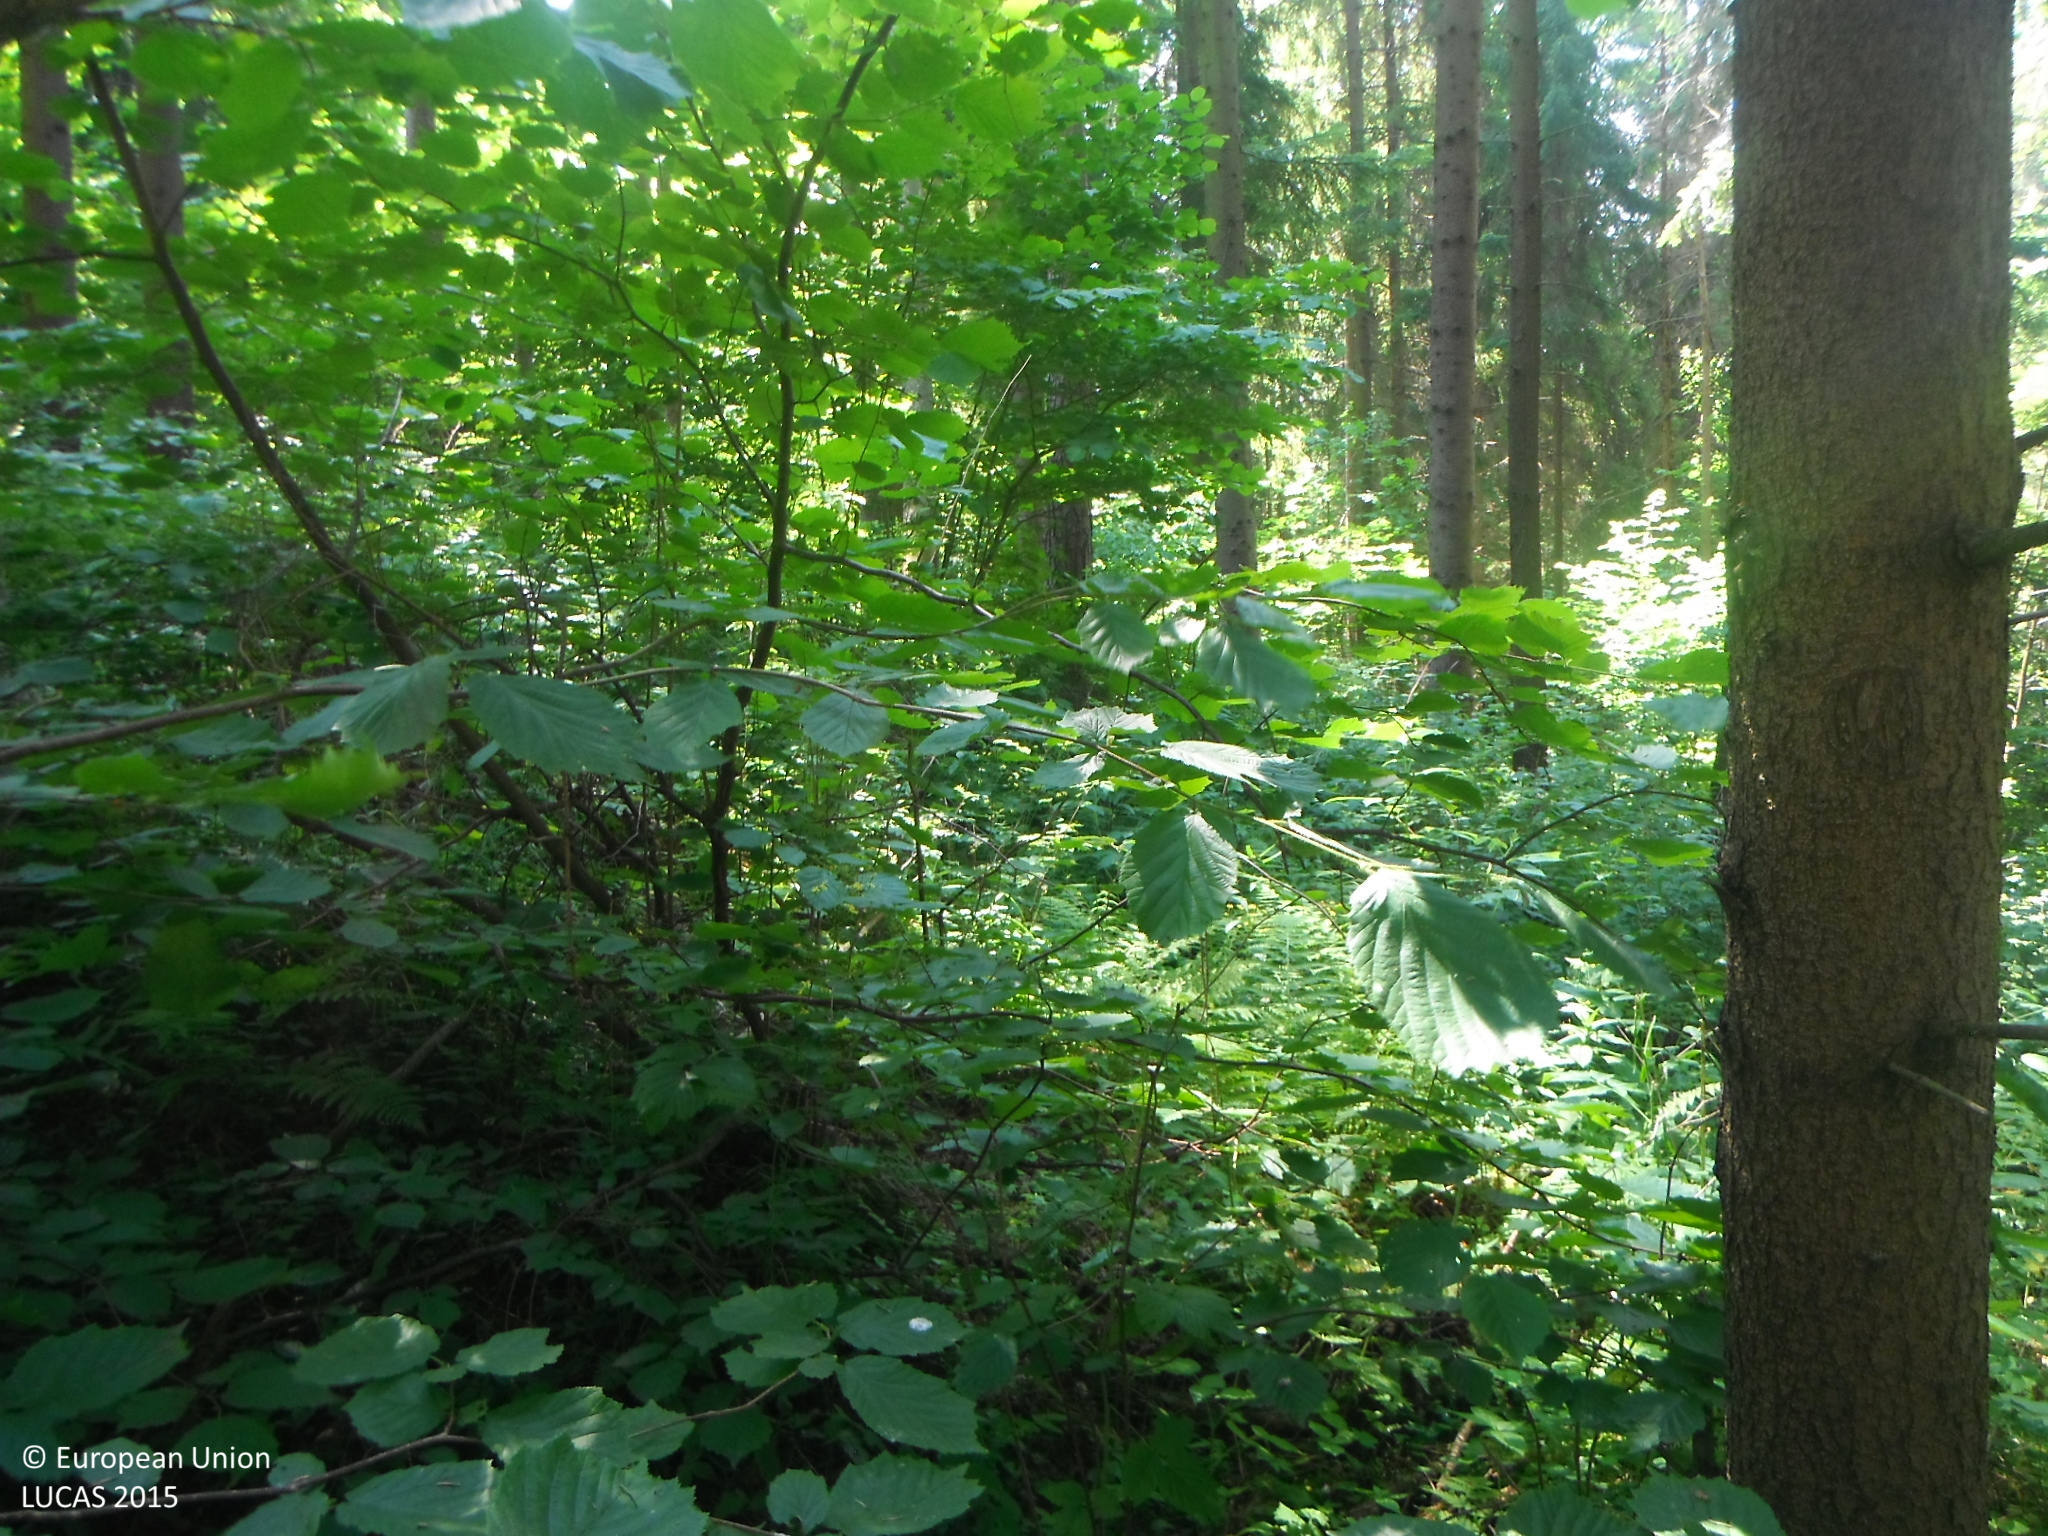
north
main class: Woodland
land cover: Other mixed woodland
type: hemiboreal forest and nemoral coniferous forest and mixed broadleaved-coniferous forest
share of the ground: > 75 %
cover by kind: coniferous forest trees 60 %, broadleaved forest trees 40 %
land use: Forestry
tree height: > 5 m
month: July
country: SK
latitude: 49.0804
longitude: 20.5099
